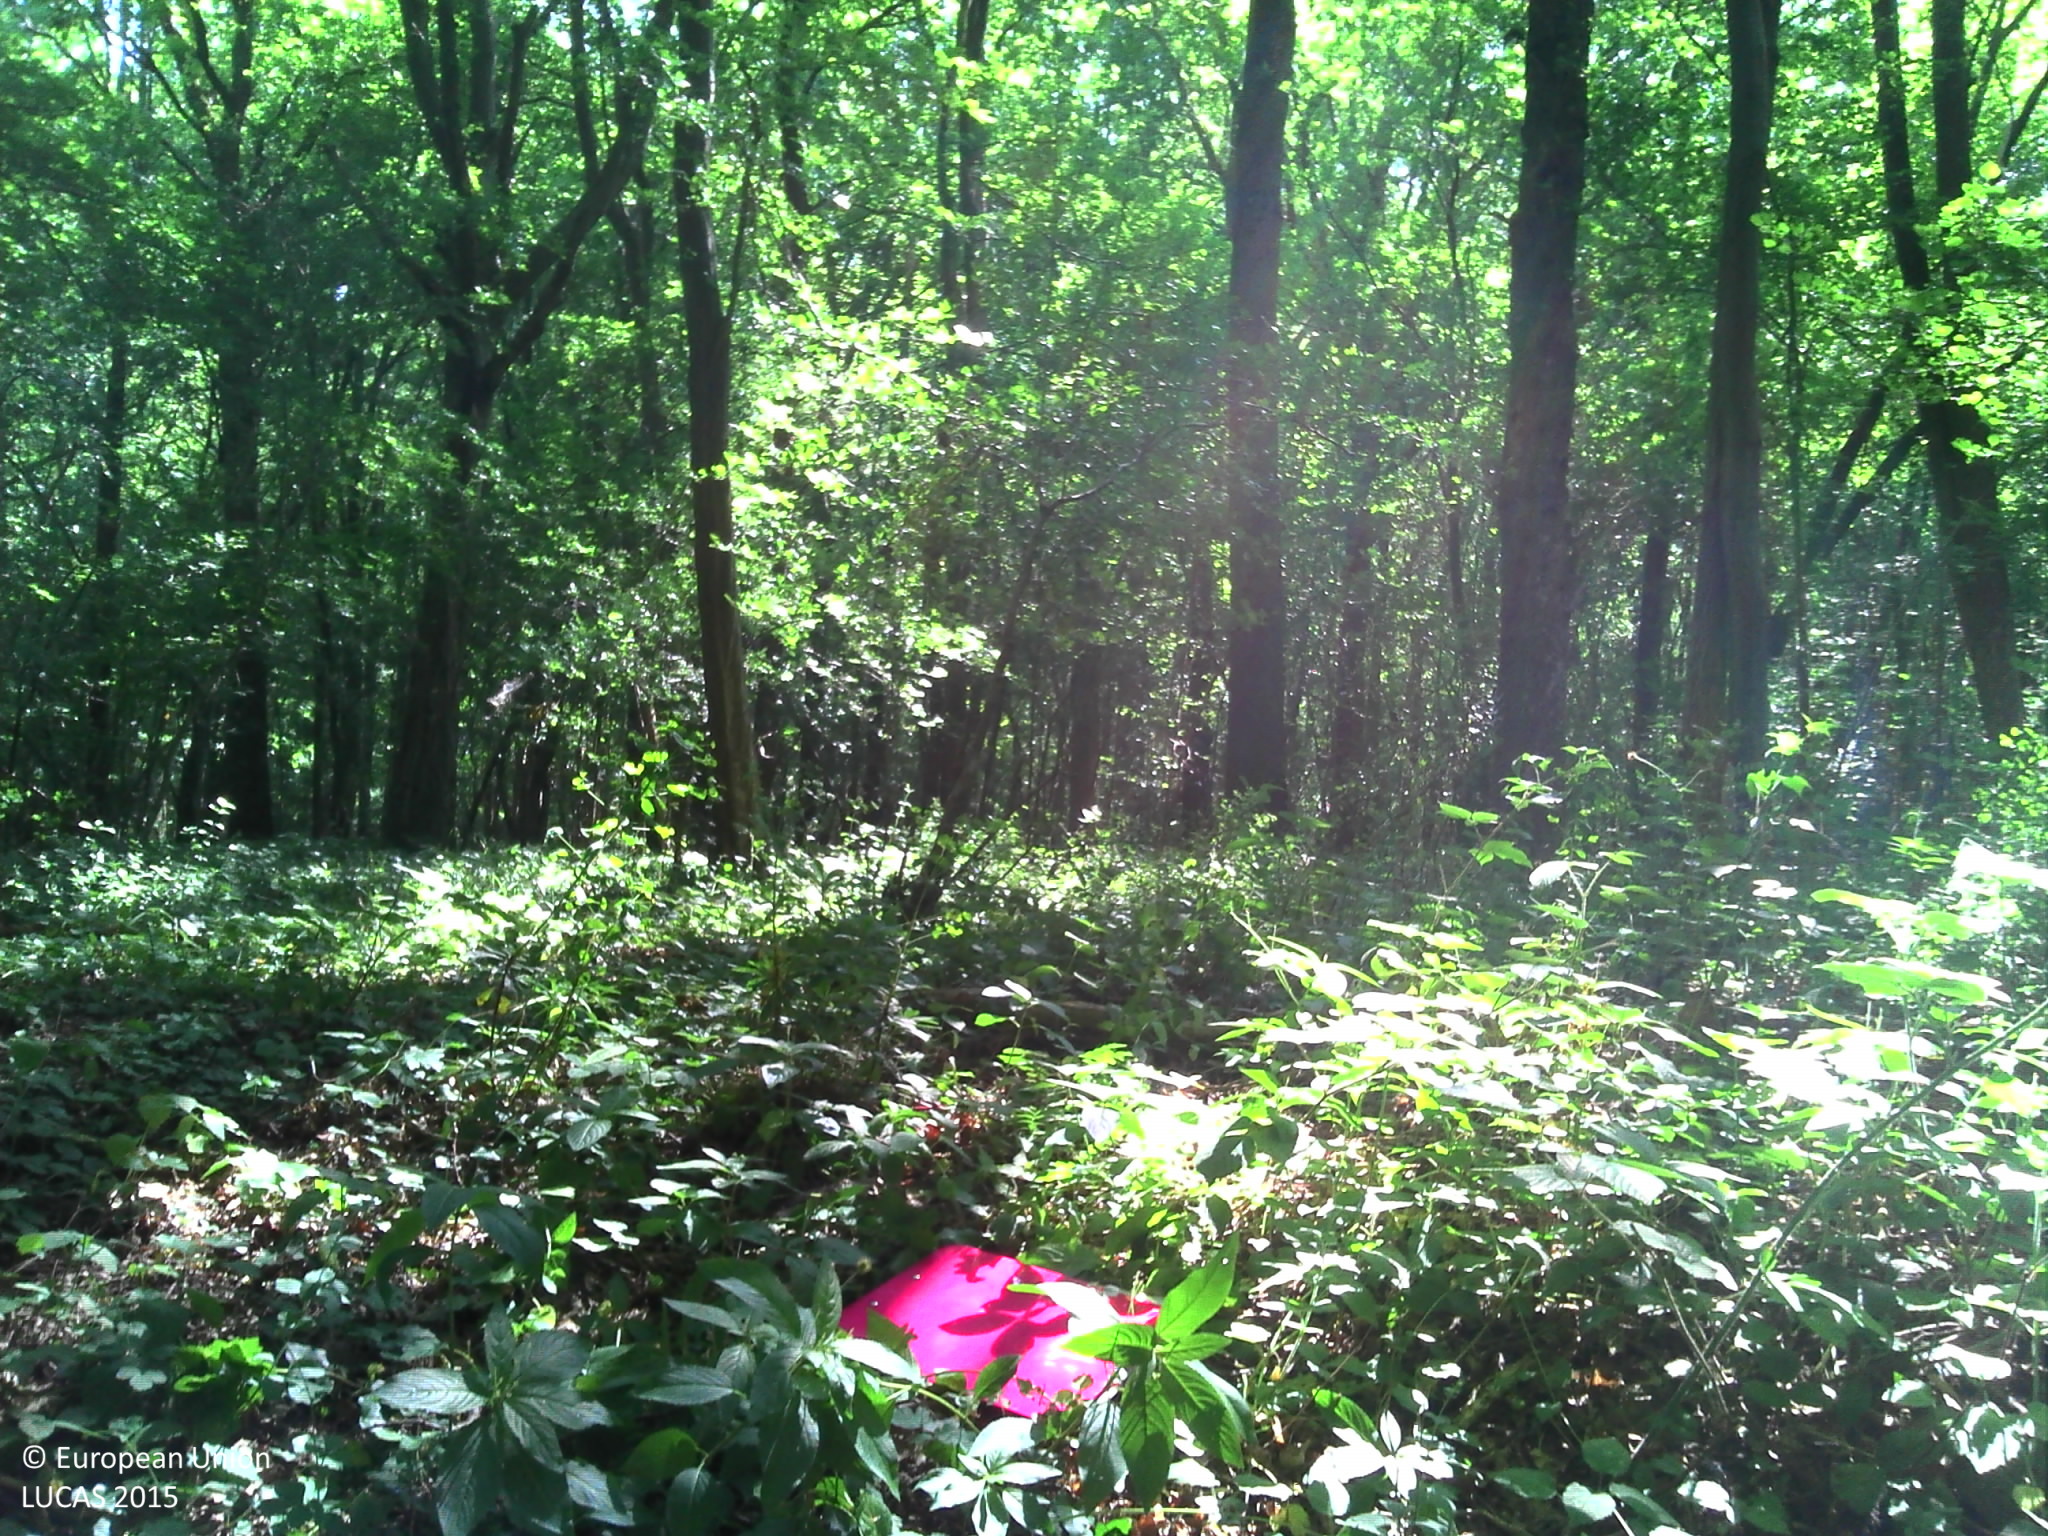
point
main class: Woodland
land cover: Broadleaved woodland
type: mesophytic deciduous forest
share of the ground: > 75 %
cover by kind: broadleaved forest trees 55 %, herbaceous plants 40 %, shrubs 5 %
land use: Forestry
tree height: > 5 m
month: June
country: FR
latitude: 49.5423
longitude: 2.5392
